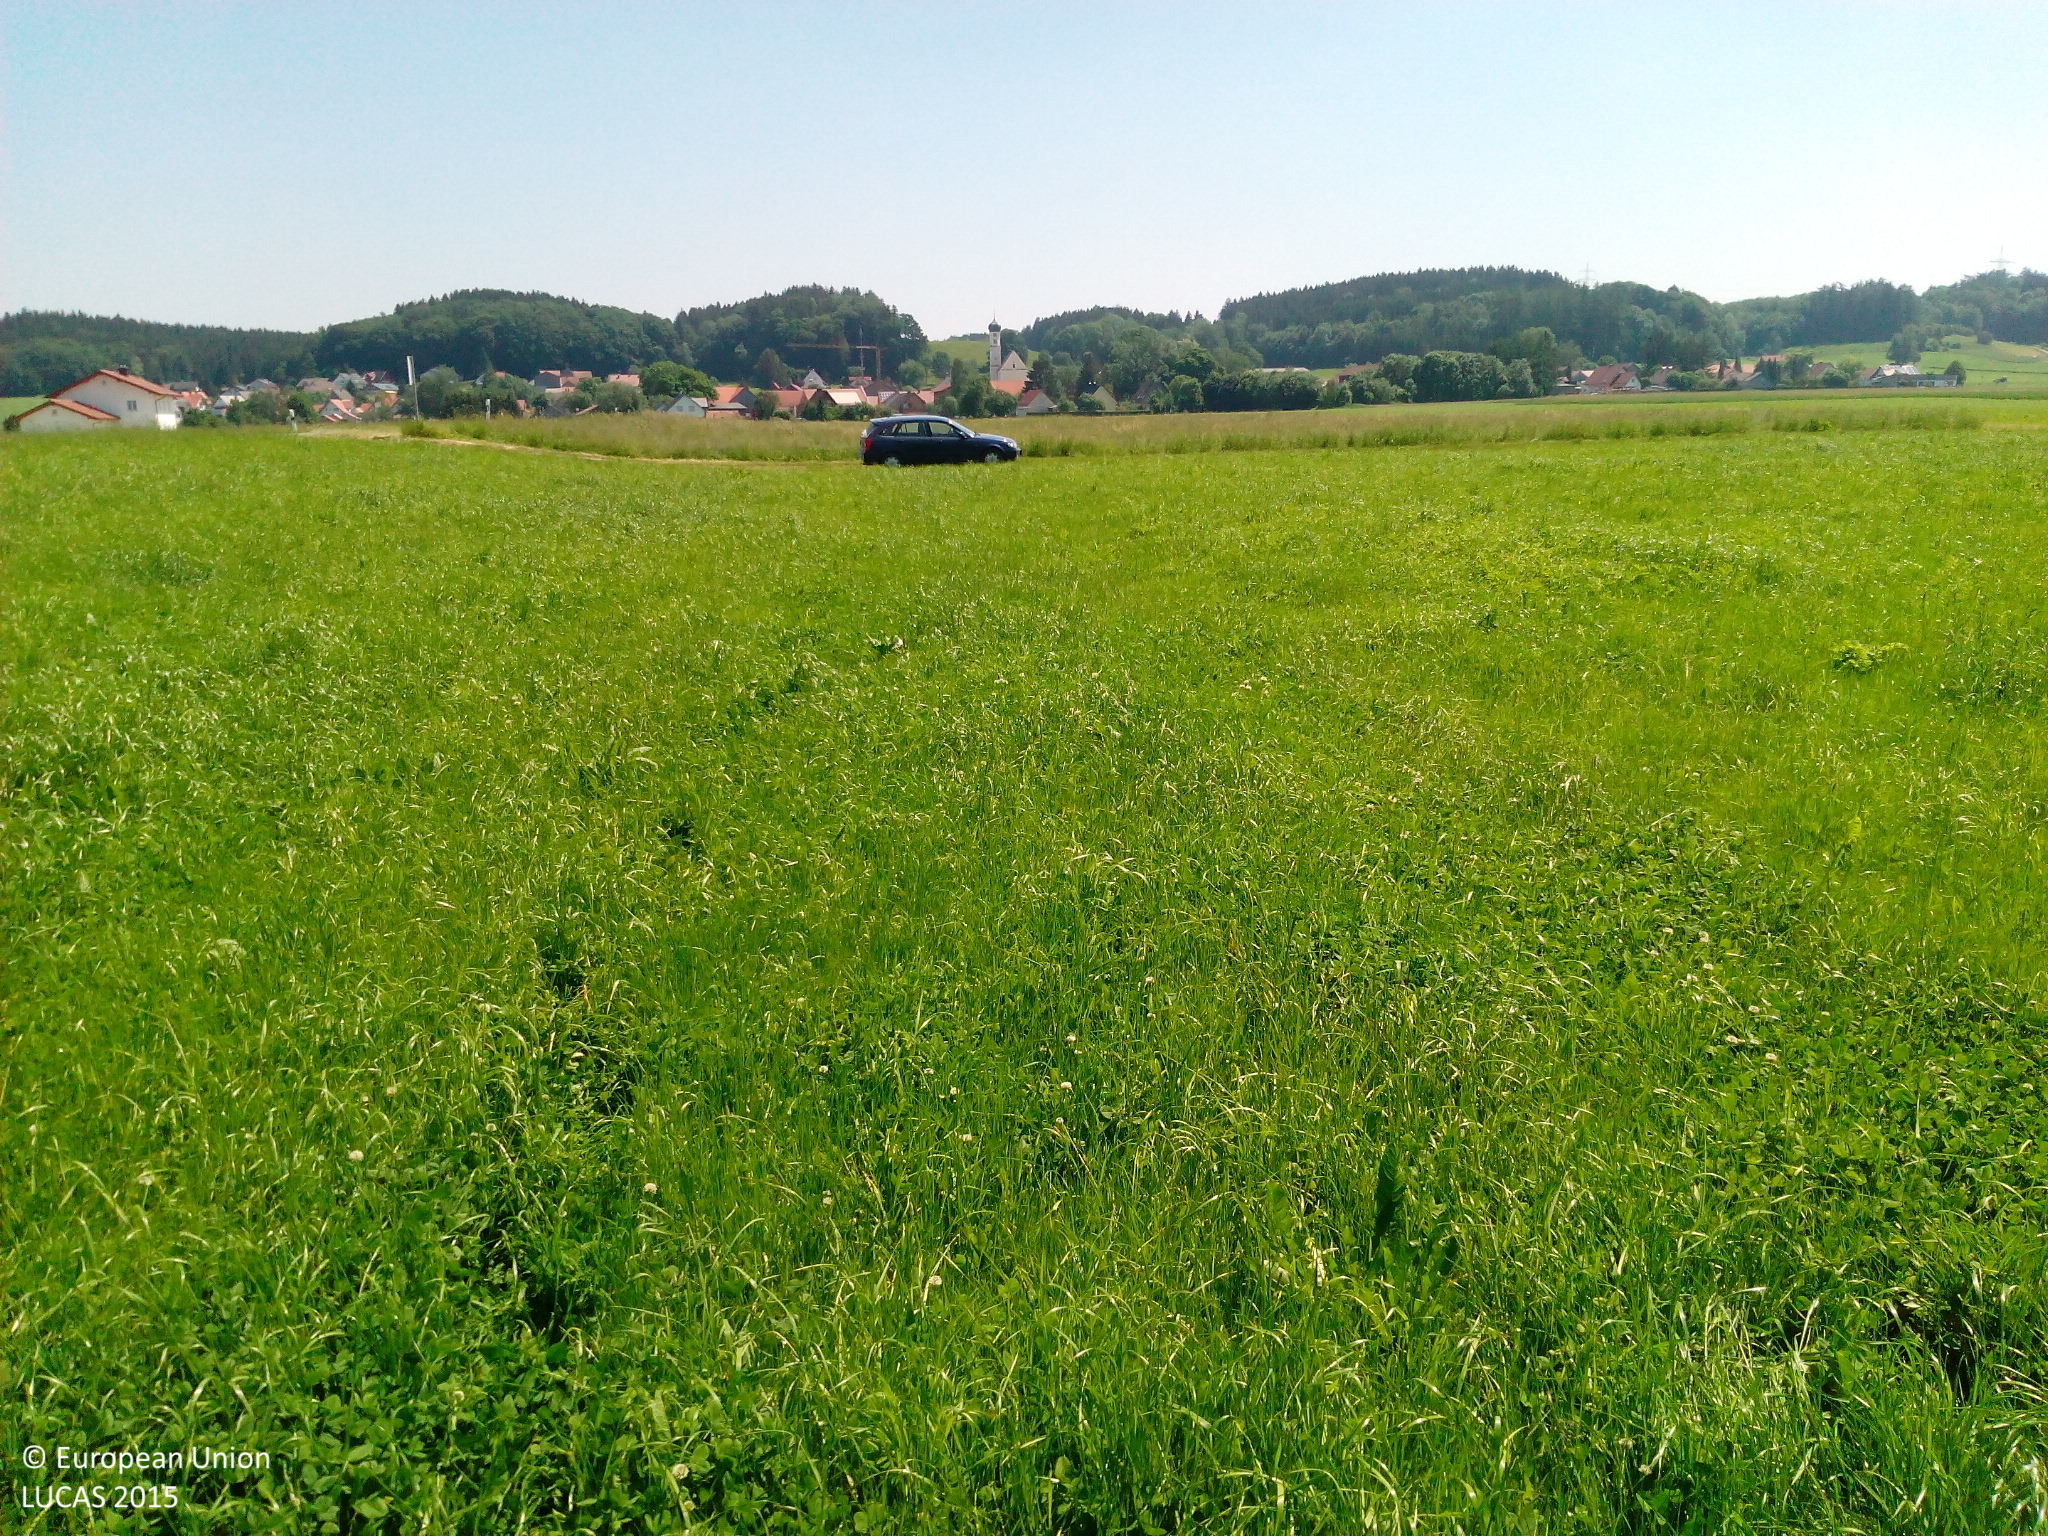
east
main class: Grassland
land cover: Grassland without tree/shrub cover
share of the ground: > 75 %
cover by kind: herbaceous plants 100 %
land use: Agriculture (excluding fallow land and kitchen gardens)
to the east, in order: Grassland without tree/shrub cover; Tracks; Grassland without tree/shrub cover
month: June
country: DE
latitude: 48.0243
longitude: 10.5226
